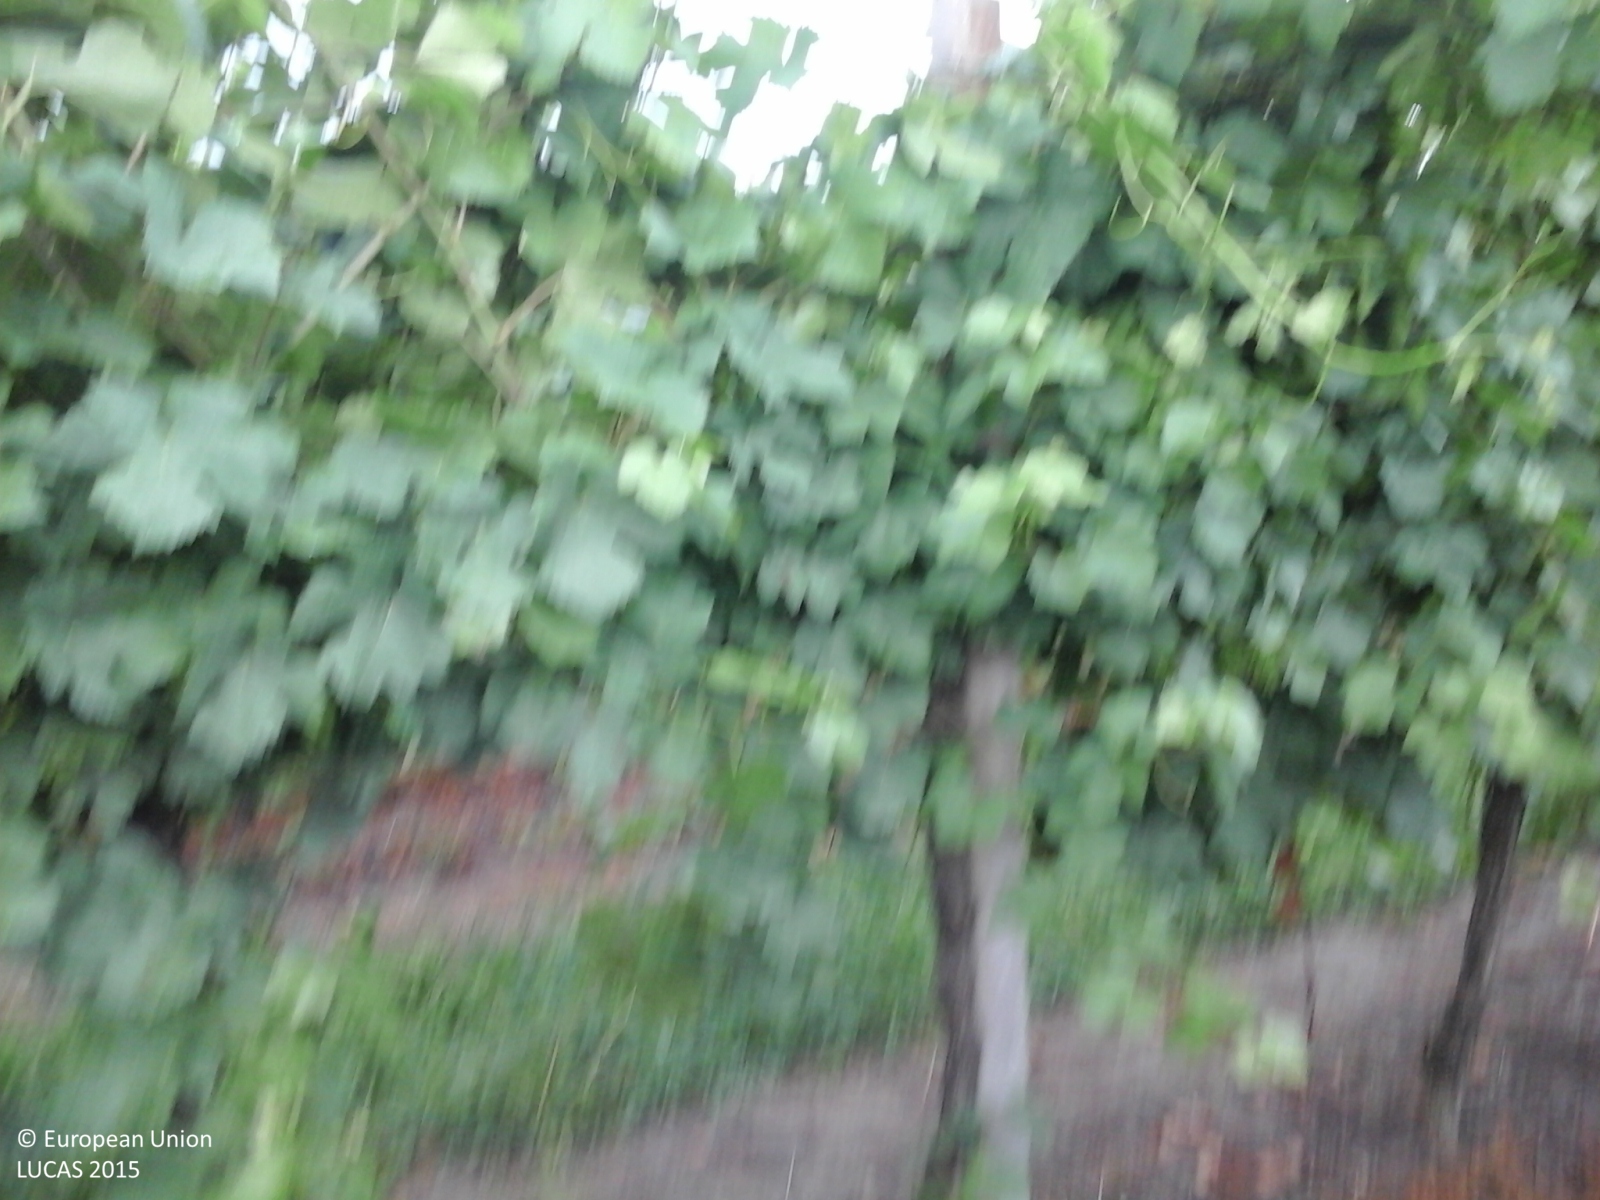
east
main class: Cropland
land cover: Vineyards
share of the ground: 25 - 50 %
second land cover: Grassland without tree/shrub cover
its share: 50 - 75 %
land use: Agriculture (excluding fallow land and kitchen gardens)
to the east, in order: Vineyards; Grassland without tree/shrub cover; Ditches and canals; Grassland without tree/shrub cover; Sugar beet; Ditches and canals; Sugar beet; Ditches and canals; Sugar beet; Ditches and canals; Sugar beet; Ditches and canals; Sugar beet; Ditches and canals; Sugar beet
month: June
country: IT
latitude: 45.6141
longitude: 12.7019
